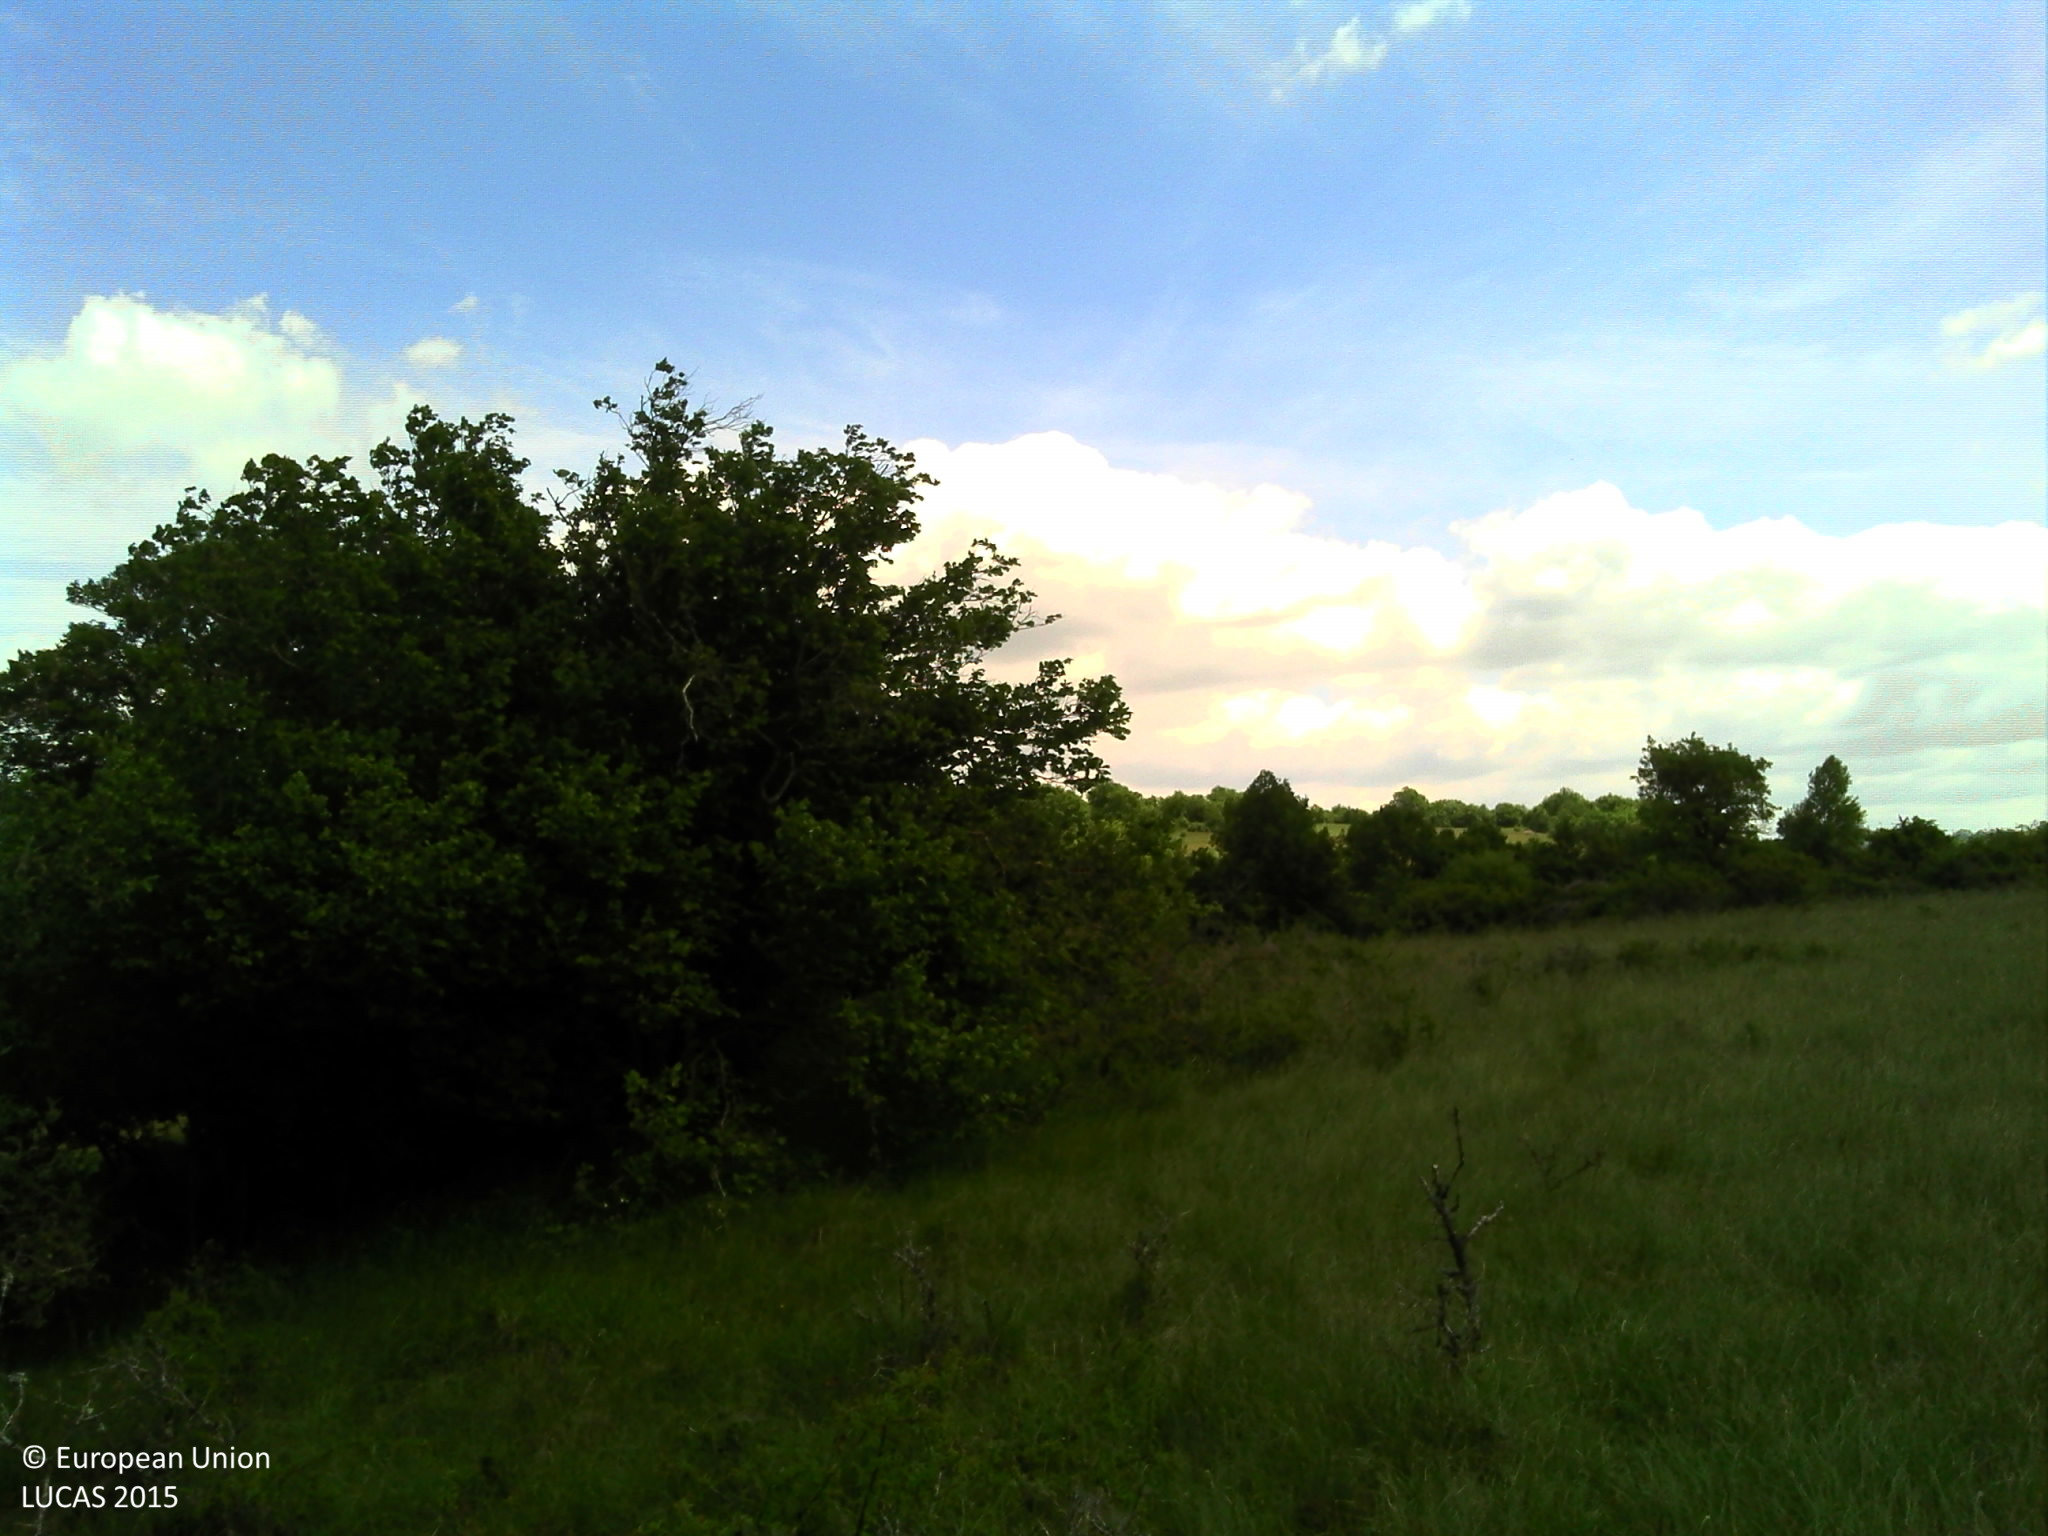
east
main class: Grassland
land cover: Grassland with sparse tree/shrub cover
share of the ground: > 75 %
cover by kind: herbaceous plants 85 %, shrubs 10 %, coniferous forest trees 5 %
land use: Agriculture (excluding fallow land and kitchen gardens)
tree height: < 5 m
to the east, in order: Grassland with sparse tree/shrub cover; Shrubland with sparse tree cover; Temporary grasslands; Fences; Dry stone walls; Lines of trees; Shrubland without tree cover; Abandoned hedges; Grass margins; Tracks; Grass margins; Lines of trees; Fences; Temporary grasslands; Lines of trees; Dry stone walls; Fences; Grassland without tree/shrub cover; Managed hedges
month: May
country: FR
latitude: 44.3359
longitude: 3.0693
